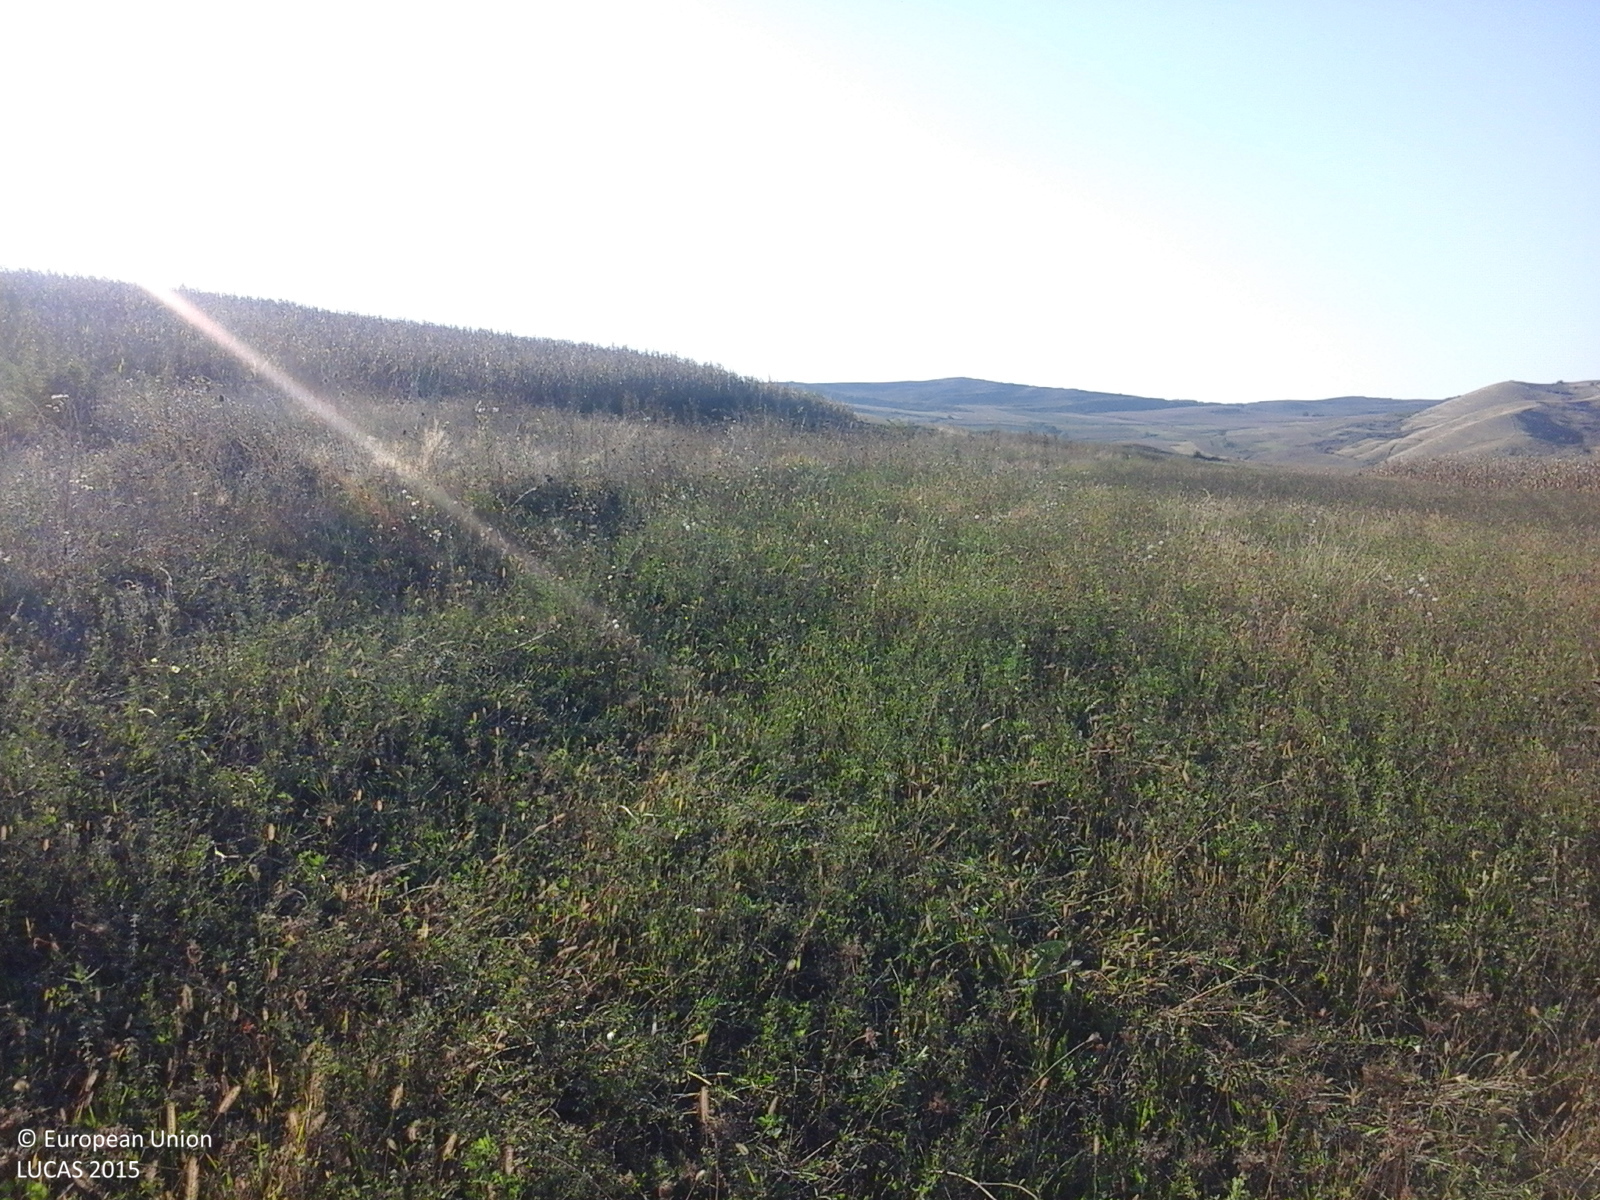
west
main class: Grassland
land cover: Spontaneously vegetated surfaces
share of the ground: > 75 %
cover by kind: herbaceous plants 100 %
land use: Agriculture (excluding fallow land and kitchen gardens)
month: October
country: RO
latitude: 46.2329
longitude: 23.8298
